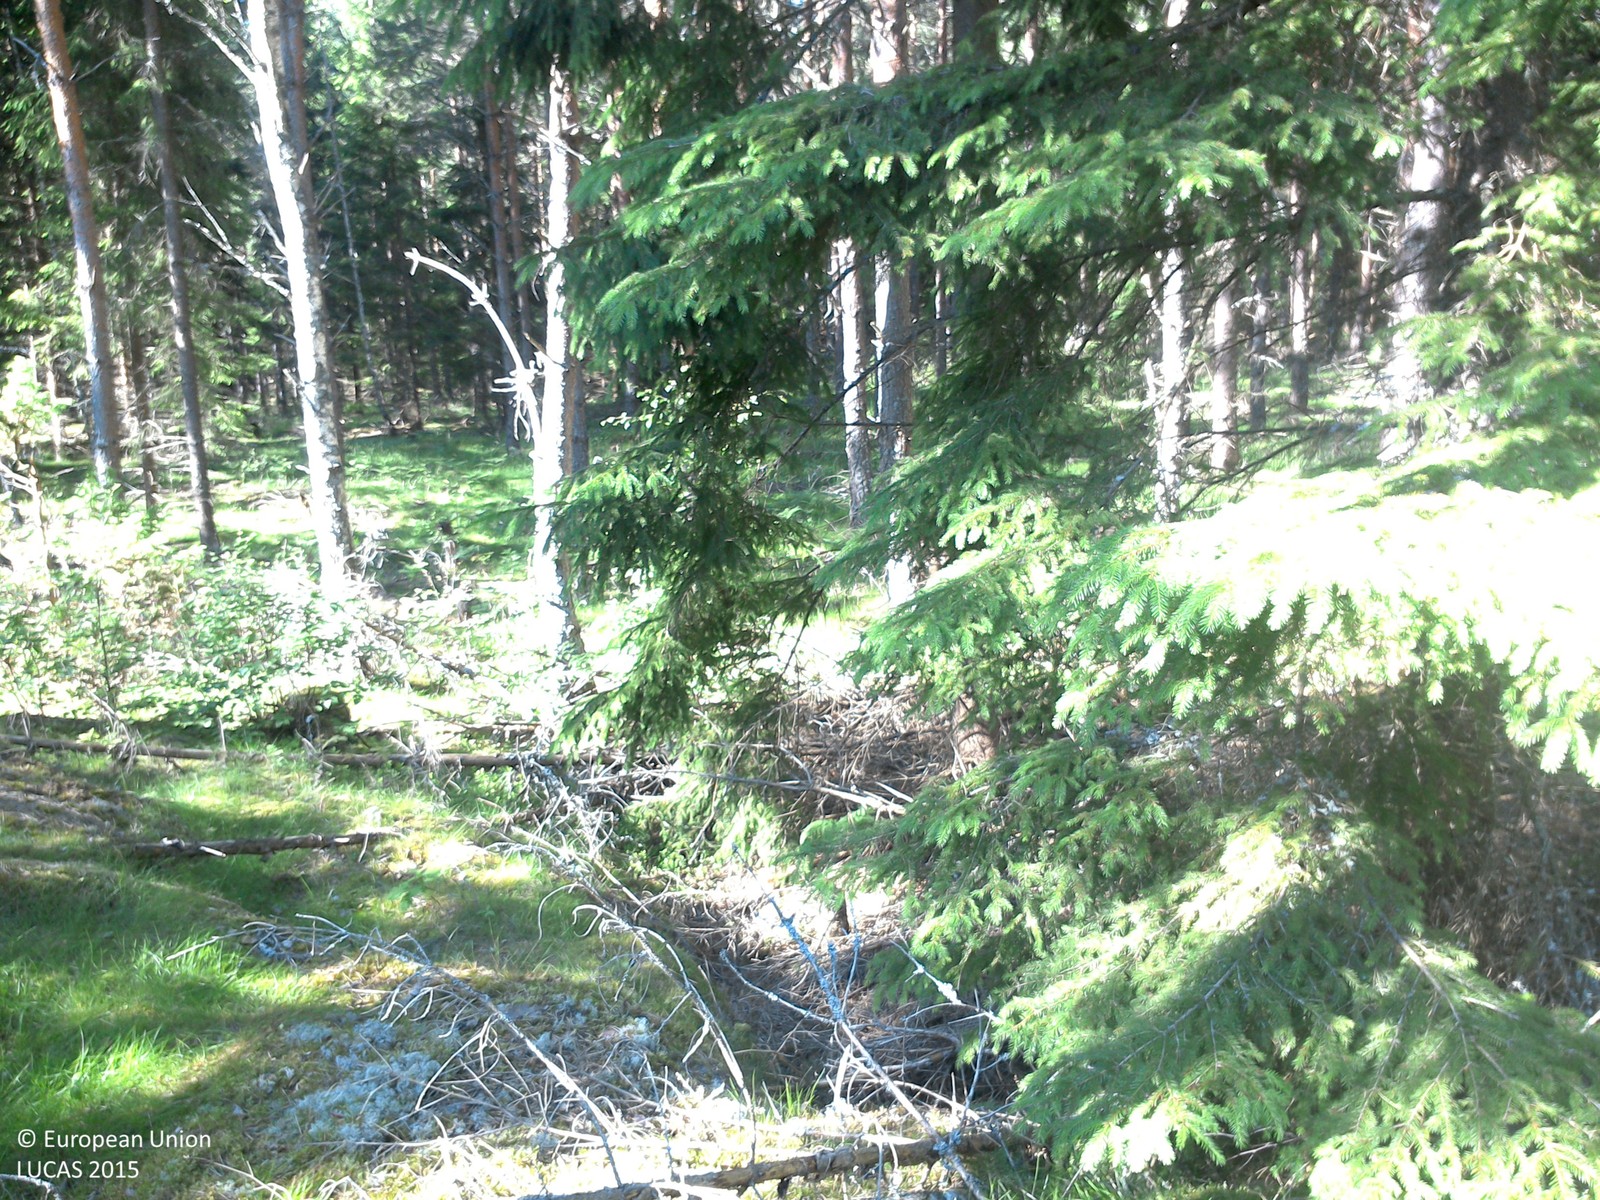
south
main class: Woodland
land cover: Spruce dominated coniferous woodland
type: boreal forest
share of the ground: 50 - 75 %
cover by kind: coniferous forest trees 65 %, lichens and mosses 20 %, herbaceous plants 15 %
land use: Forestry
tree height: > 5 m
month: June
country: SE
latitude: 57.9906
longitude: 15.6962
